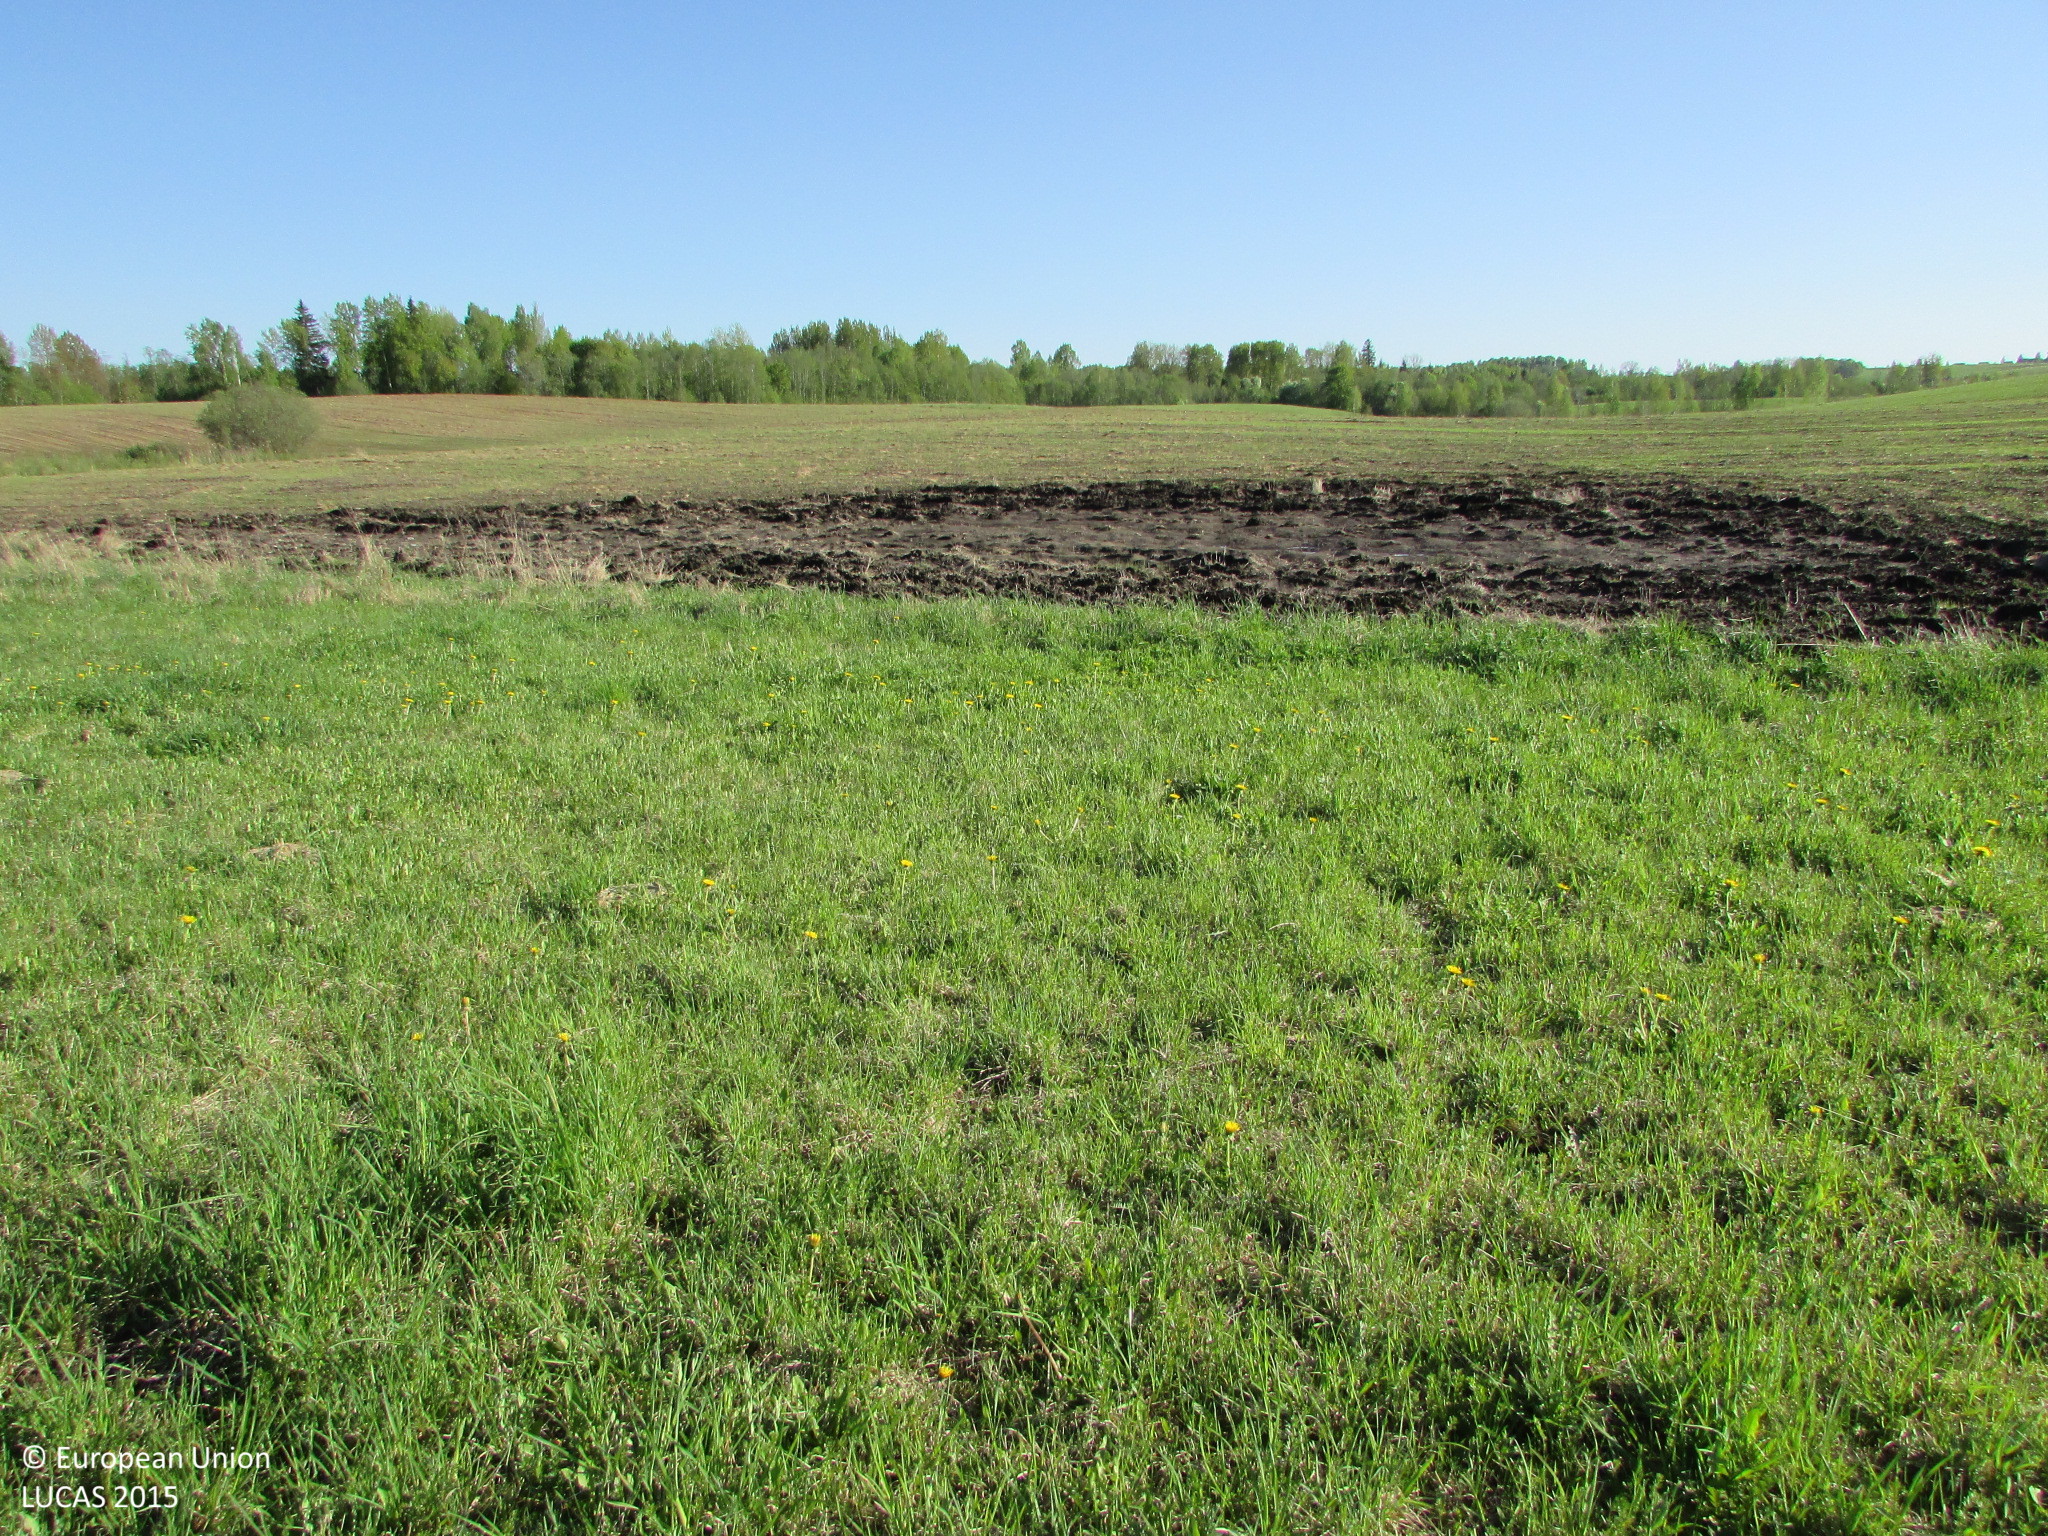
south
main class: Grassland
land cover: Grassland without tree/shrub cover
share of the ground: > 75 %
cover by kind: herbaceous plants 100 %
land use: Agriculture (excluding fallow land and kitchen gardens)
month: May
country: LV
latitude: 55.9019
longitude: 27.5701
